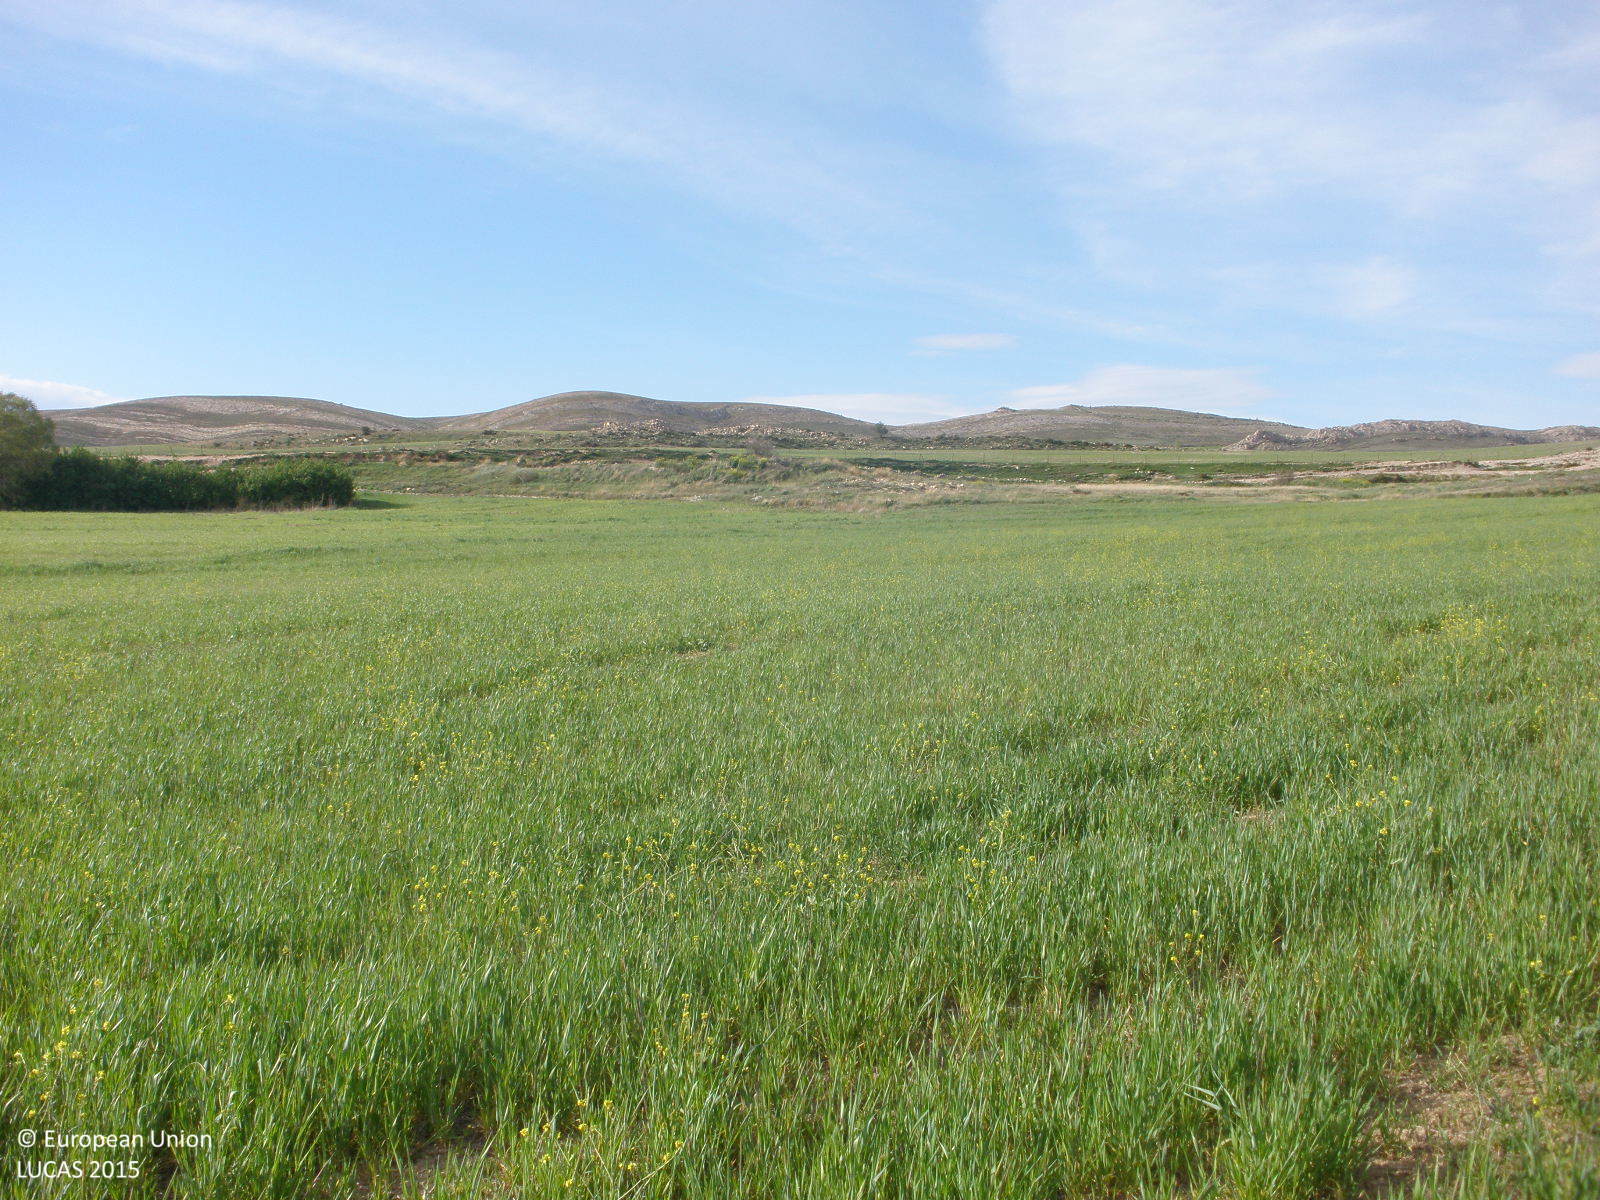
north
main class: Cropland
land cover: Common wheat
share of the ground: > 75 %
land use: Agriculture (excluding fallow land and kitchen gardens)
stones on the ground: < 10 %
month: May
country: ES
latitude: 40.6376
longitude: -0.7831
